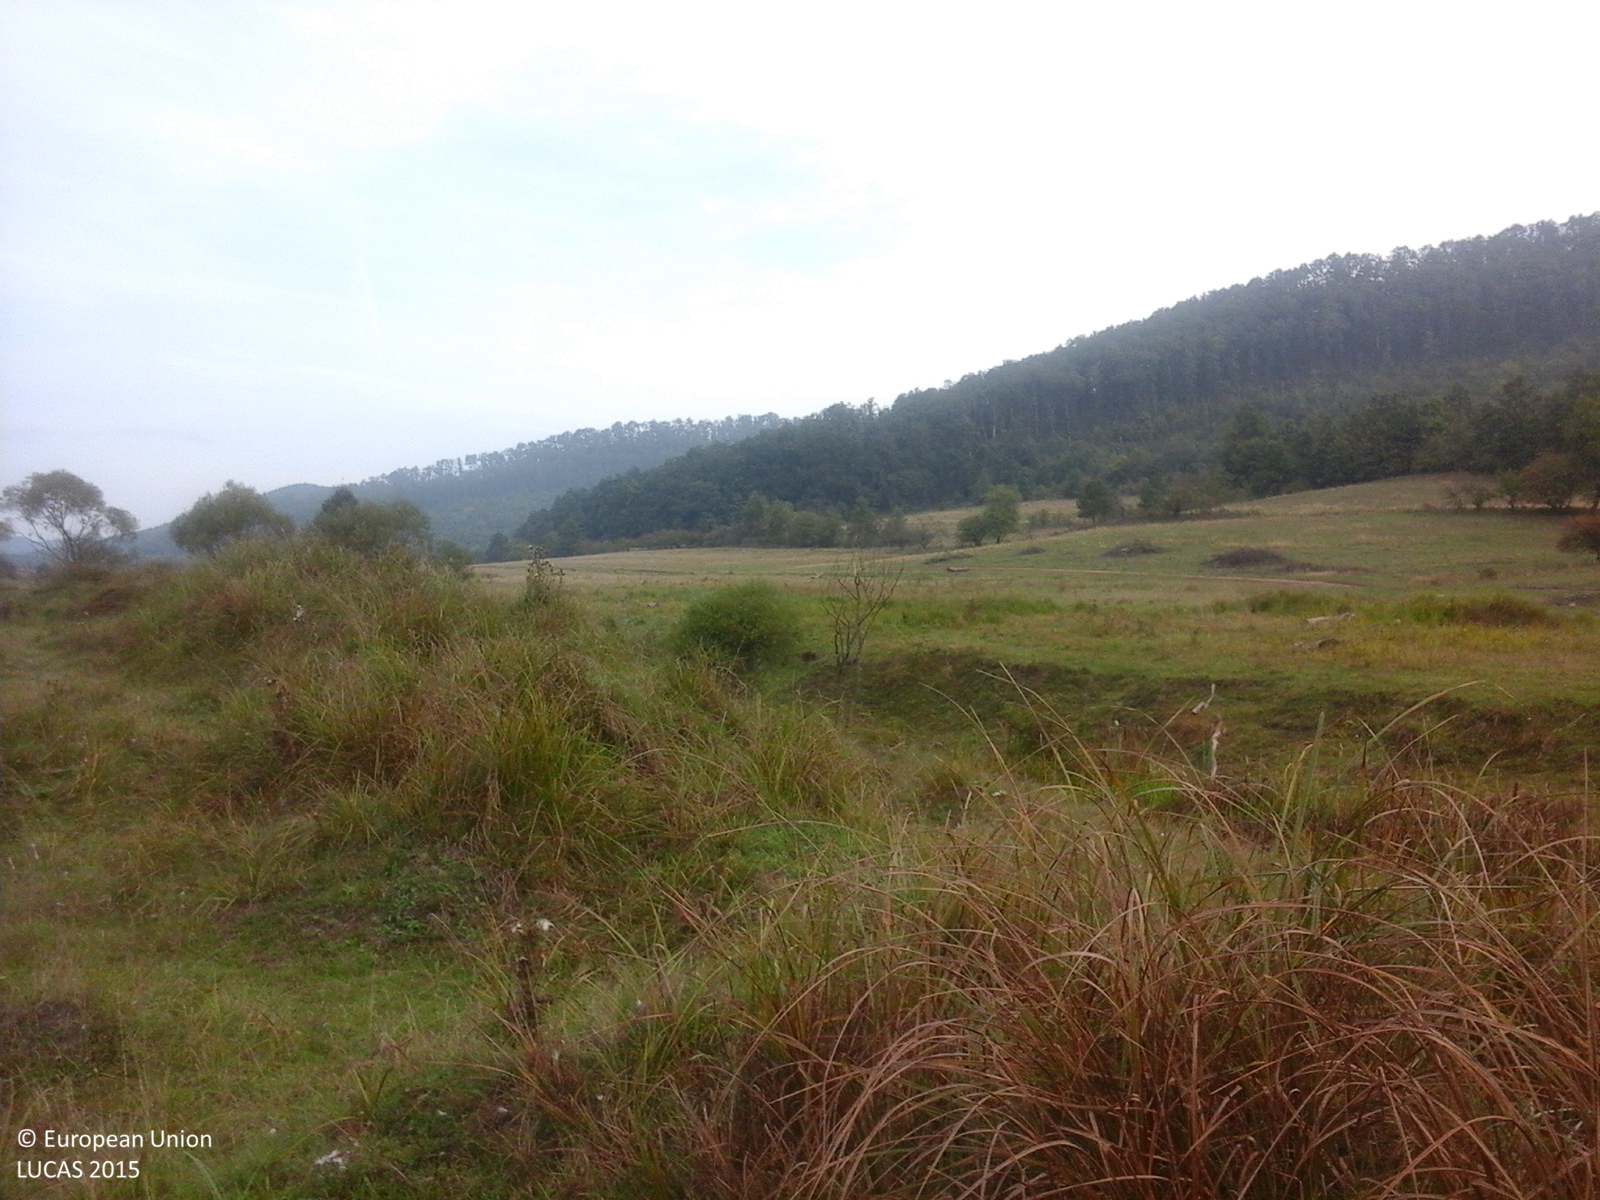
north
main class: Grassland
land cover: Spontaneously vegetated surfaces
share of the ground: > 75 %
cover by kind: herbaceous plants 100 %
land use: Agriculture (excluding fallow land and kitchen gardens)
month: September
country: RO
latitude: 46.9798
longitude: 23.1182
